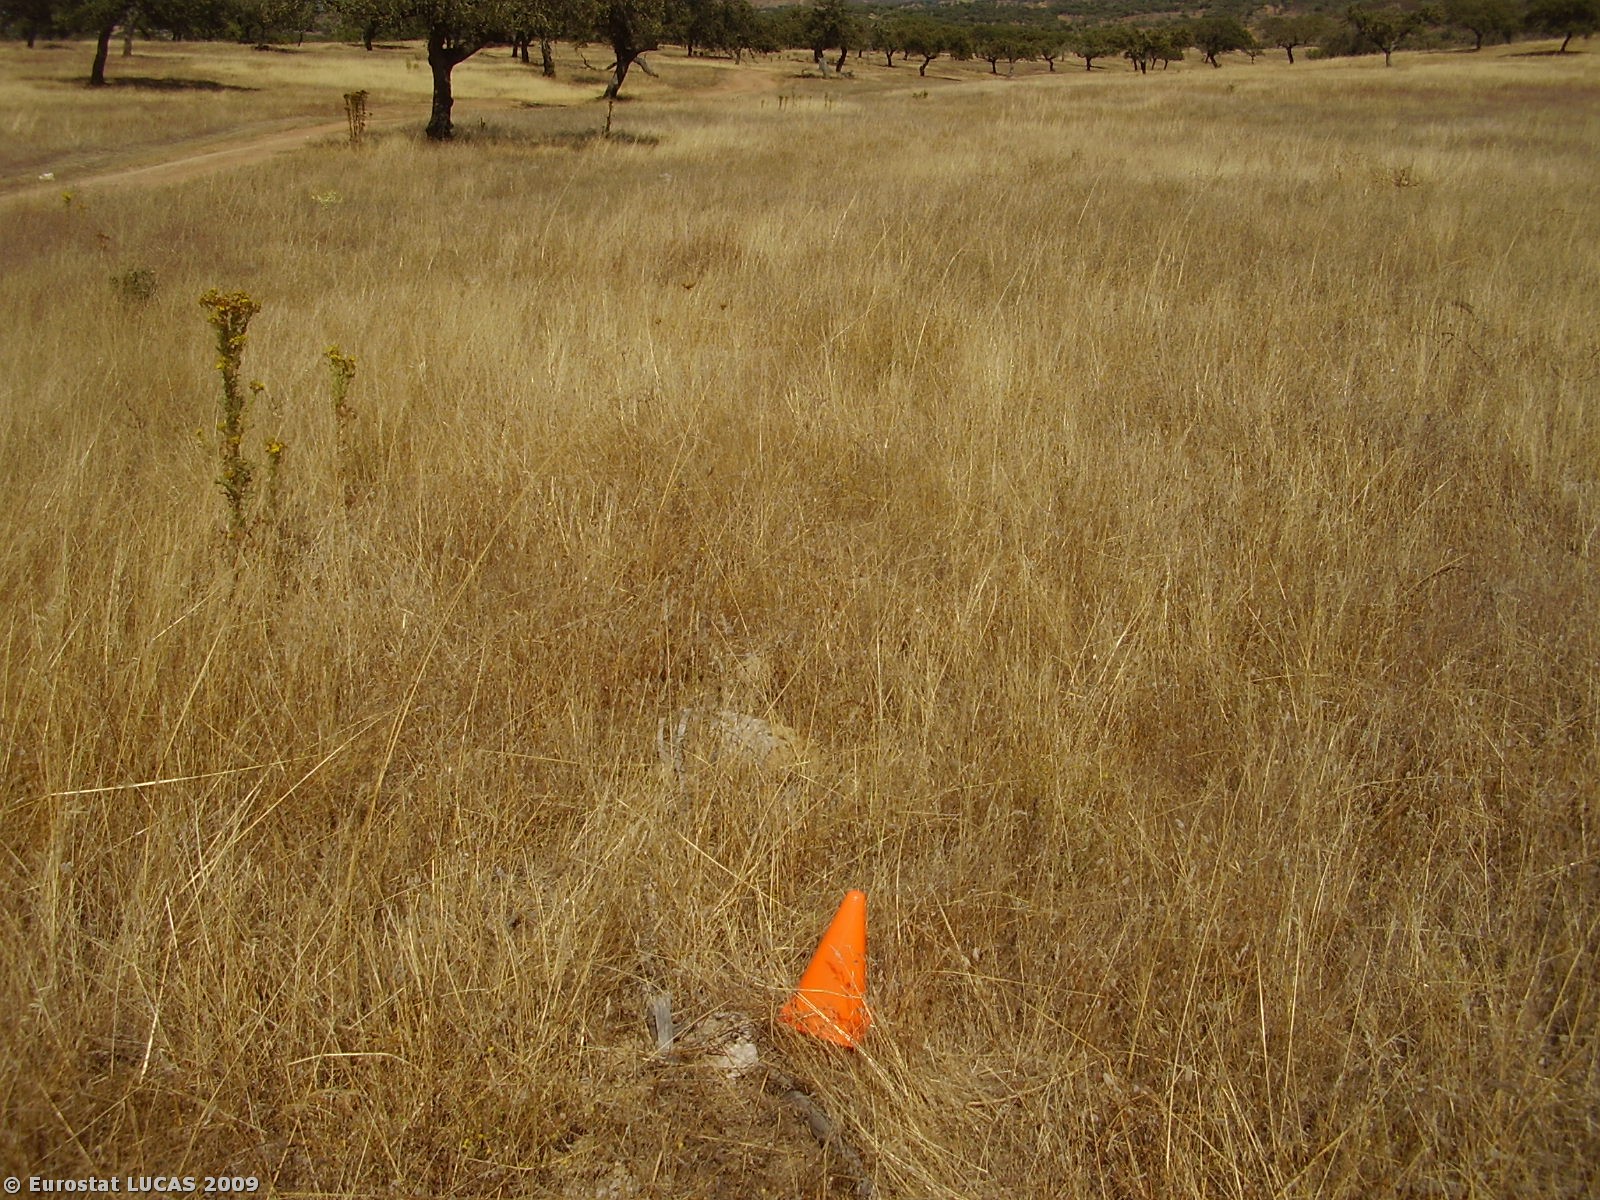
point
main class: Grassland
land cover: Grassland without tree/shrub cover
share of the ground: > 75 %
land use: Fallow land
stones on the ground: 25 - 50 %
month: July
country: PT
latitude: 37.8834
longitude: -7.5155
